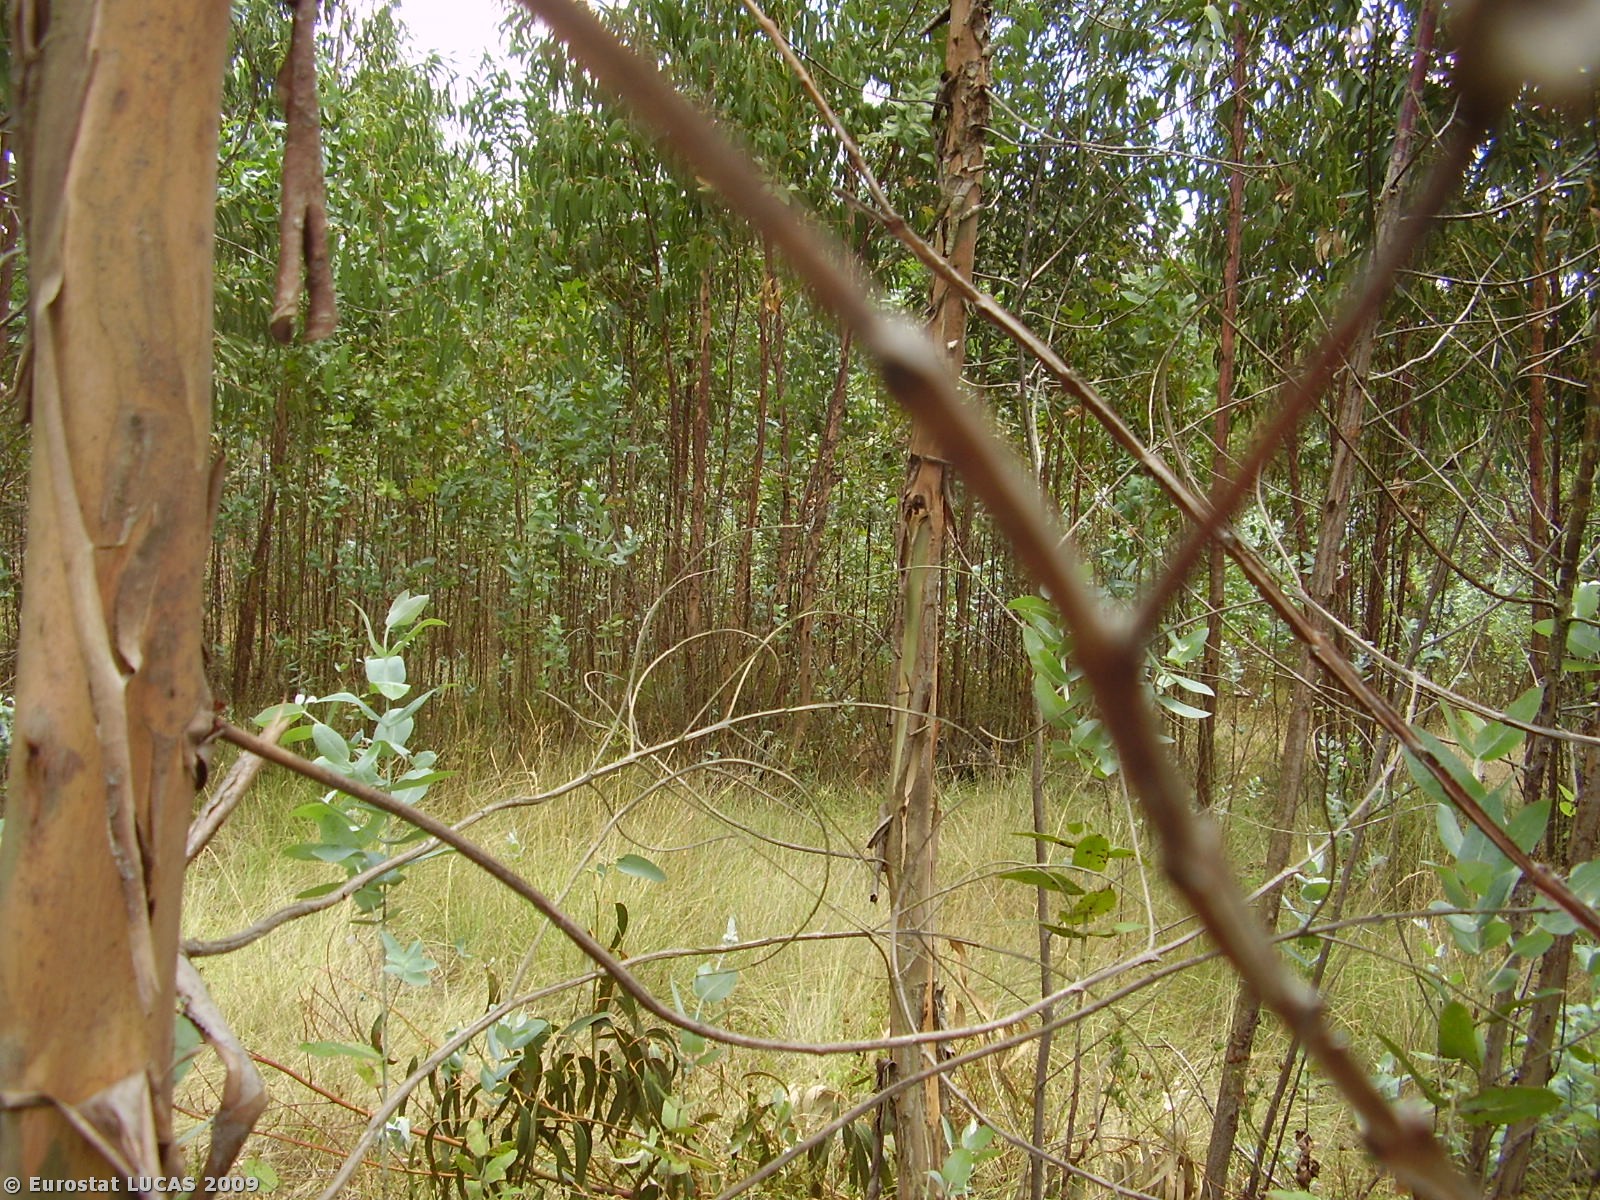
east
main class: Woodland
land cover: Broadleaved woodland
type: plantations and self-sown exotic forest
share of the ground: 25 - 50 %
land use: Forestry
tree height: > 5 m
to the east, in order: Broadleaved woodland; Spontaneously vegetated surfaces; Broadleaved woodland; Spontaneously vegetated surfaces; Fences; Tracks; Broadleaved woodland; Tracks; Broadleaved woodland
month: July
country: PT
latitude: 39.4981
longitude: -8.3605
